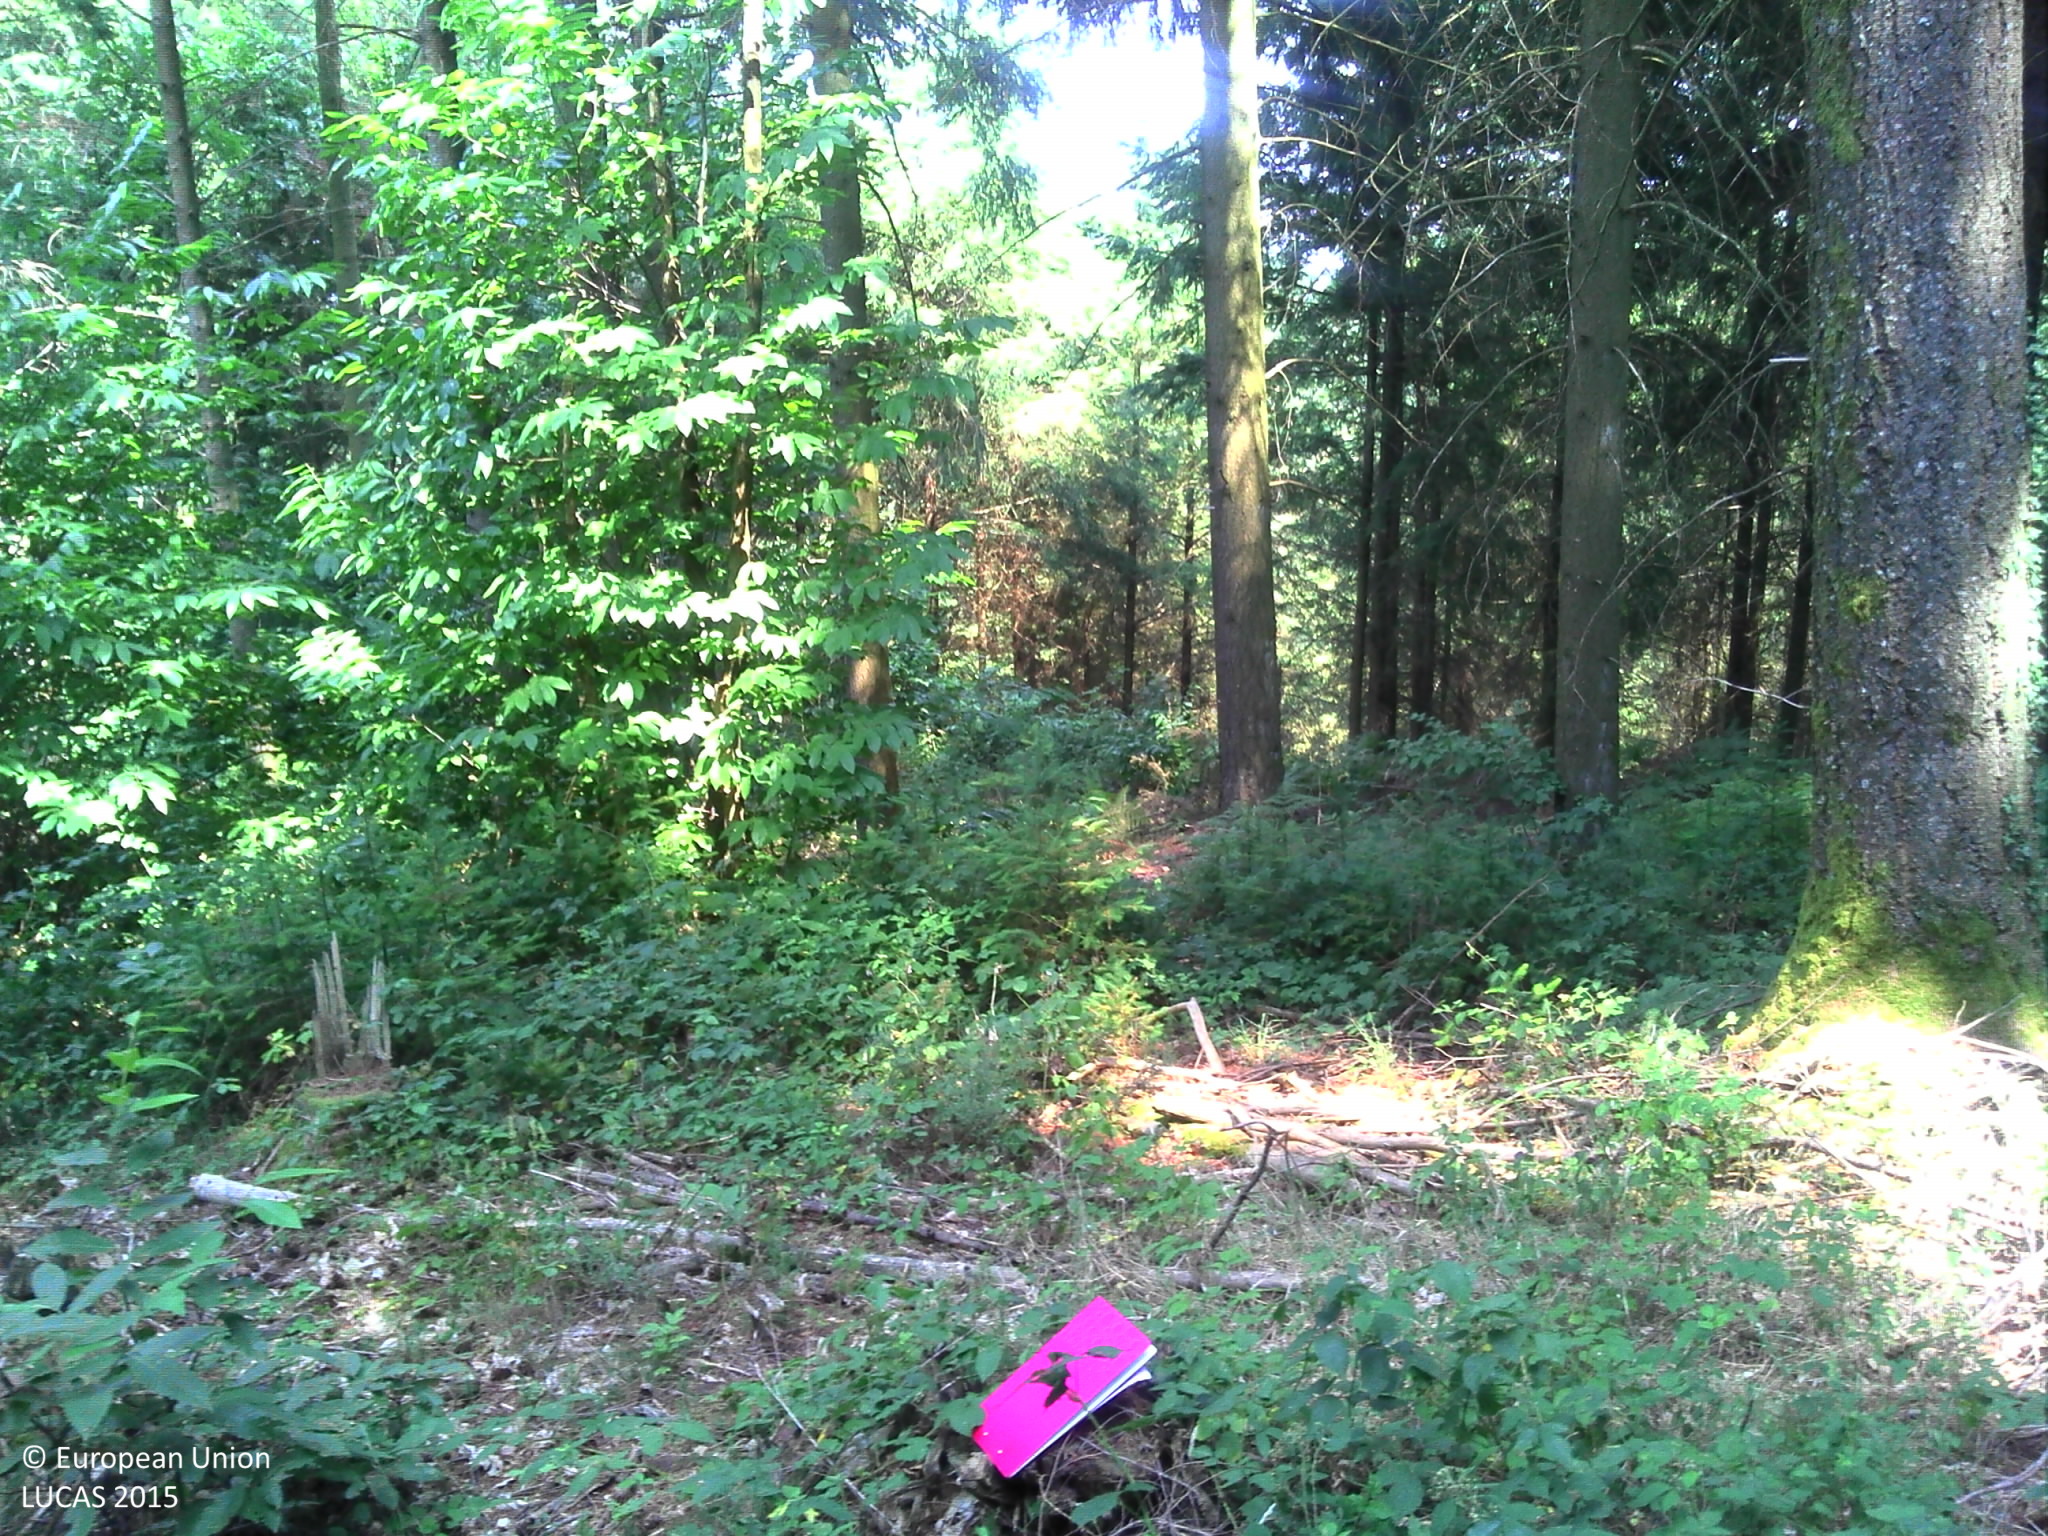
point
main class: Woodland
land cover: Spruce dominated coniferous woodland
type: exotic forest
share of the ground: > 75 %
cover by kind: coniferous forest trees 60 %, broadleaved forest trees 15 %, shrubs 10 %, lichens and mosses 10 %, herbaceous plants 5 %
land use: Forestry
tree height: > 5 m
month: July
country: FR
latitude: 45.9616
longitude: 1.7738
